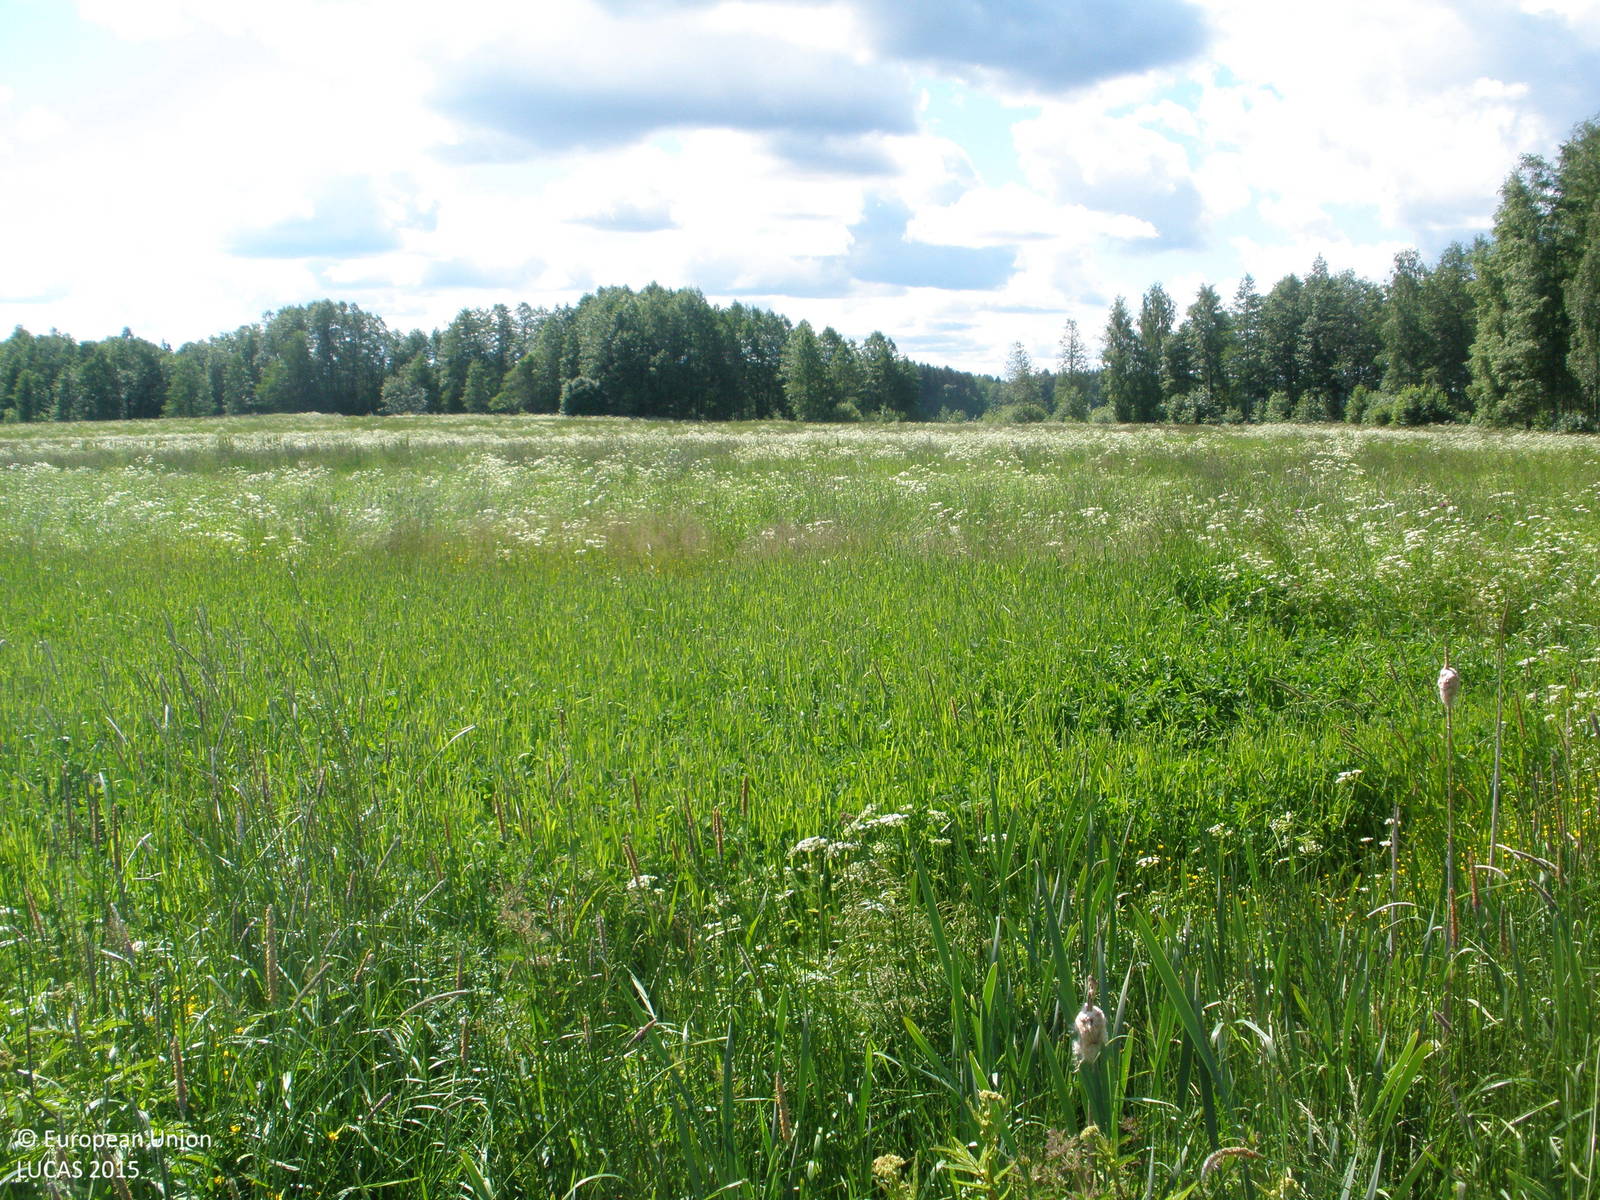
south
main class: Grassland
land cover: Grassland without tree/shrub cover
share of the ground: > 75 %
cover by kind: herbaceous plants 100 %
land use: Agriculture (excluding fallow land and kitchen gardens)
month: June
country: FI
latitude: 61.0751
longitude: 24.1628
